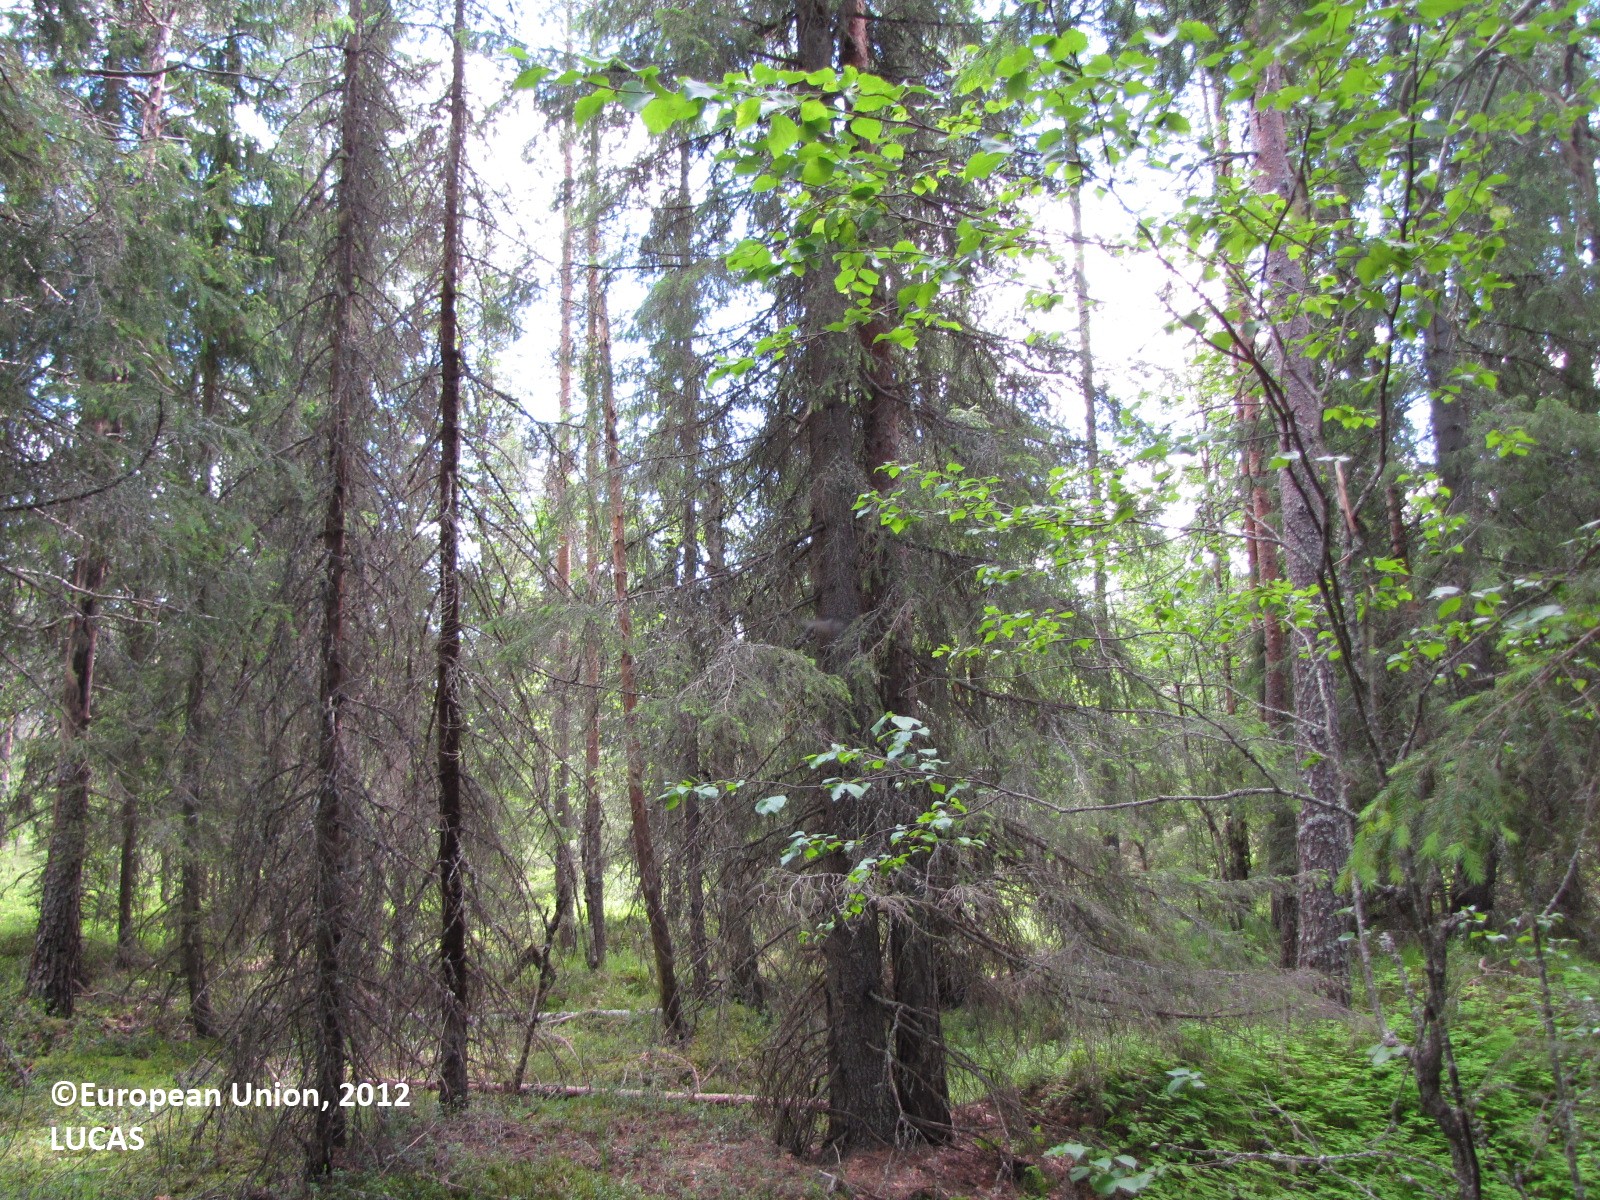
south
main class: Woodland
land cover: Spruce dominated coniferous woodland
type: boreal forest
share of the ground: 50 - 75 %
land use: Forestry
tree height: > 5 m
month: July
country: FI
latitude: 66.2377
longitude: 25.1164
